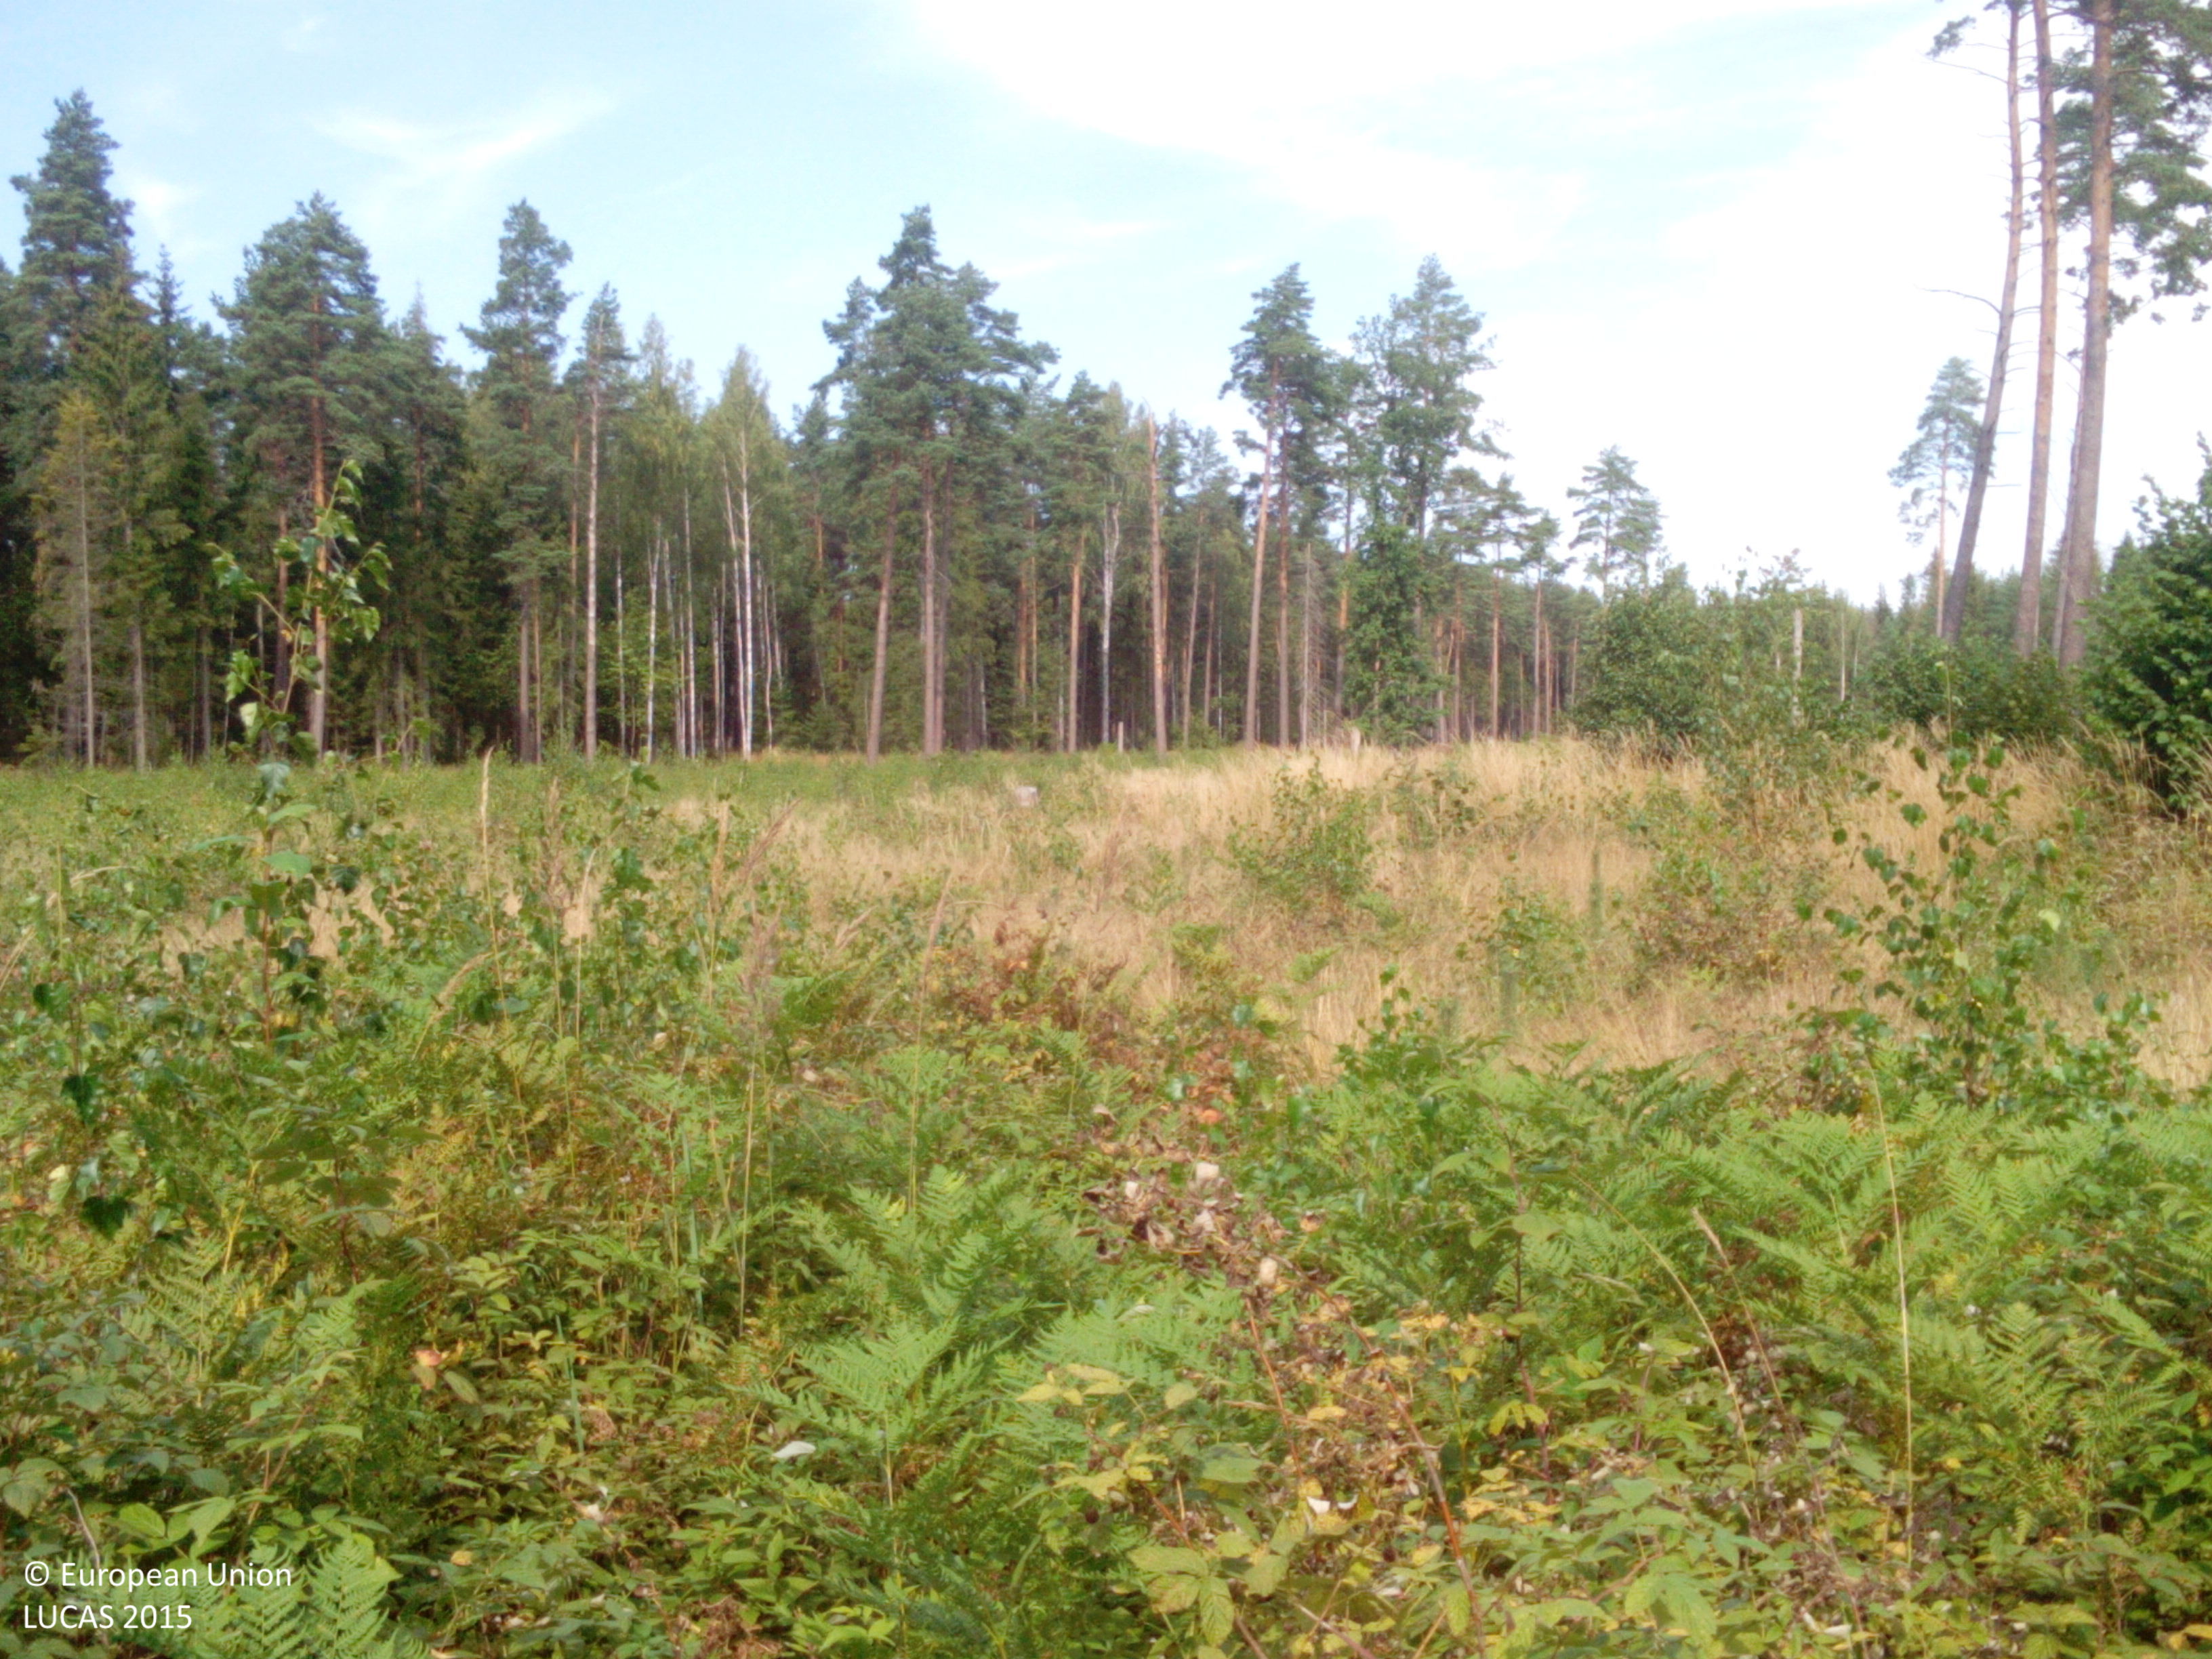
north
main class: Grassland
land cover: Grassland with sparse tree/shrub cover
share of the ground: > 75 %
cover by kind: herbaceous plants 85 %, shrubs 10 %, broadleaved forest trees 5 %
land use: Forestry
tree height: < 5 m
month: August
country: LV
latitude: 56.3305
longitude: 21.2147
